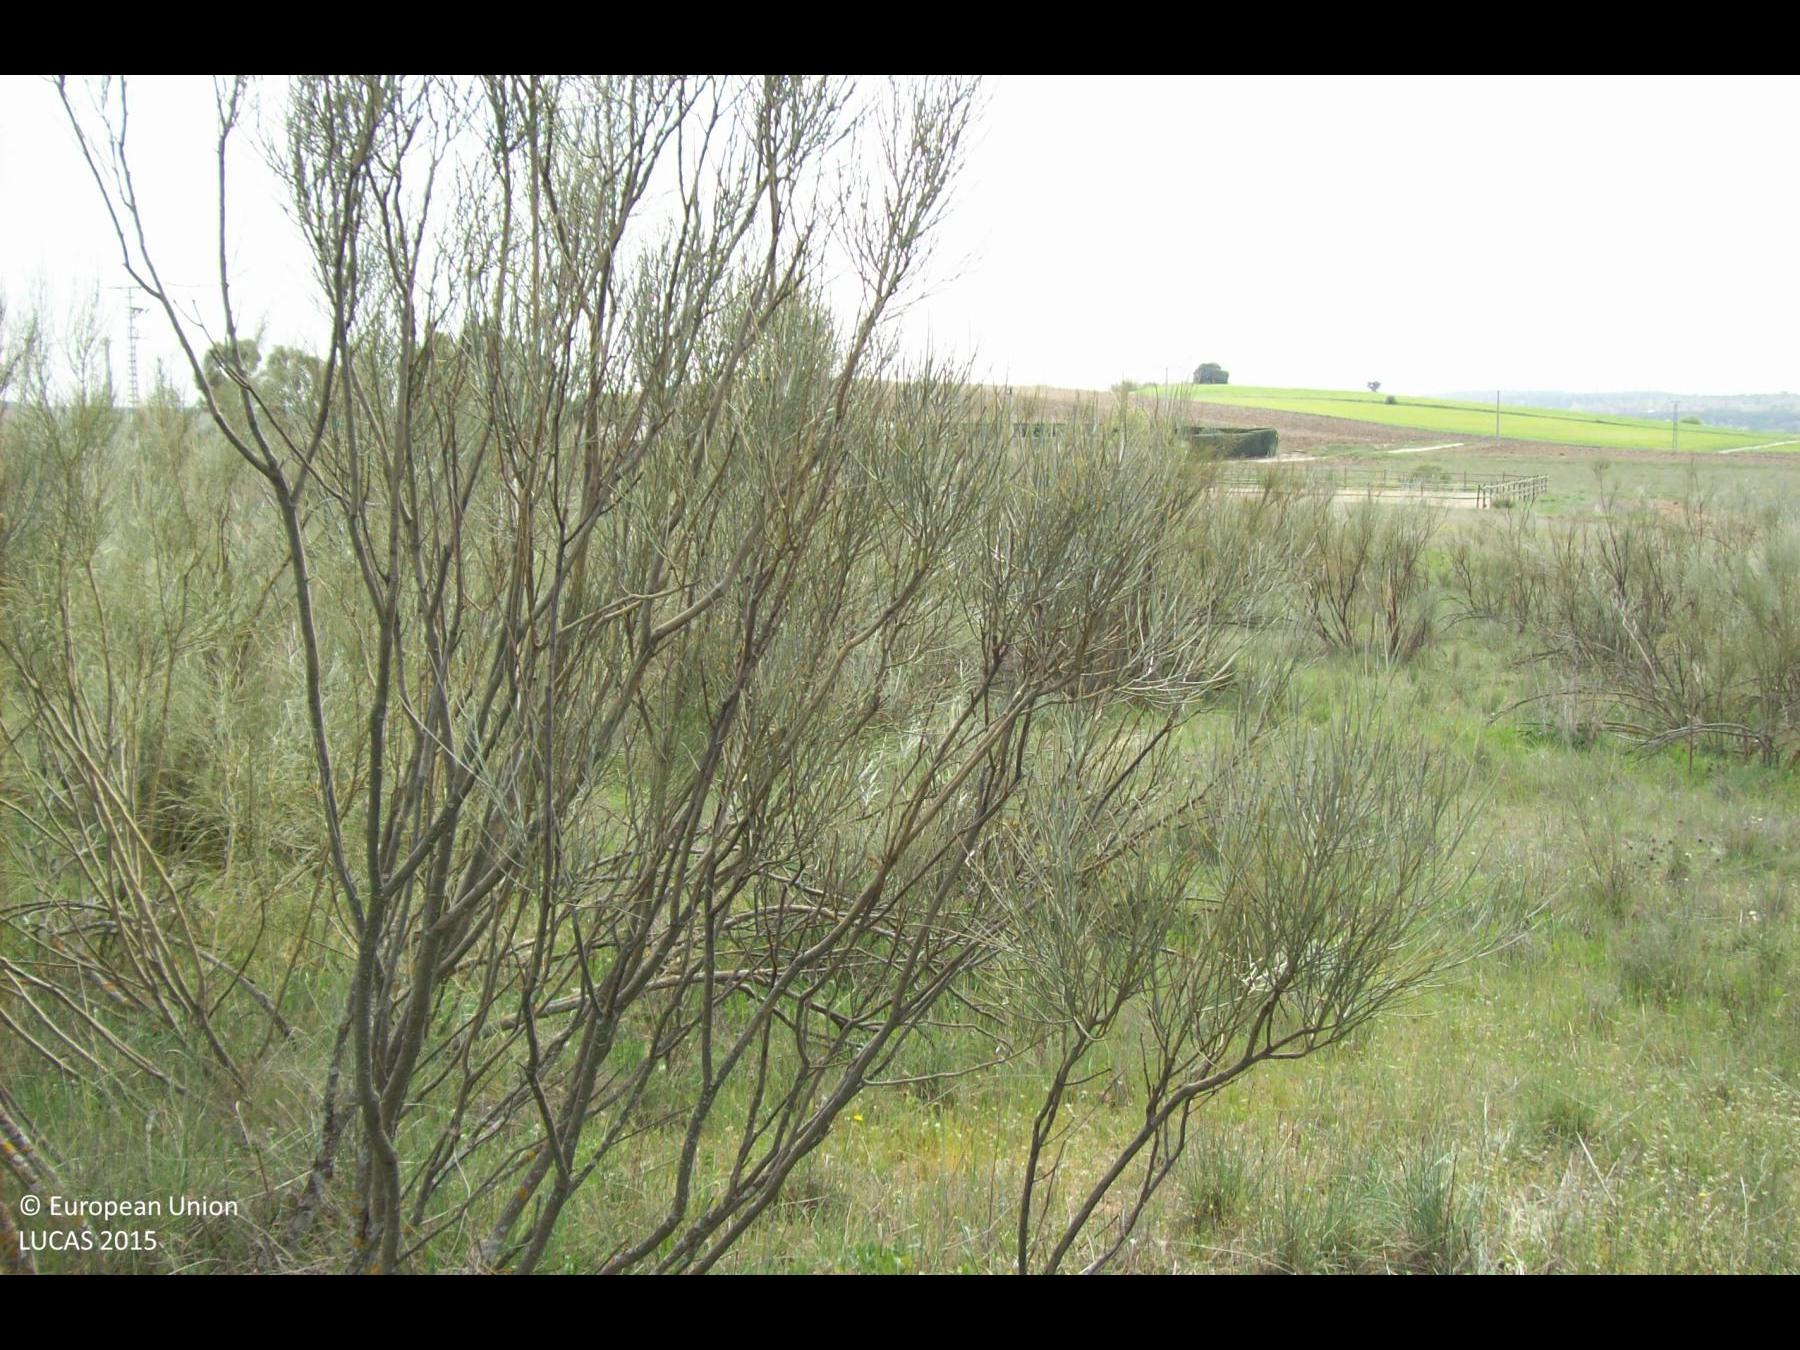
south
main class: Shrubland
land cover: Shrubland without tree cover
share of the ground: > 75 %
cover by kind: shrubs 50 %, herbaceous plants 50 %
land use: Semi-natural and natural areas not in use
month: April
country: ES
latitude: 40.4784
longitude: -3.9252
